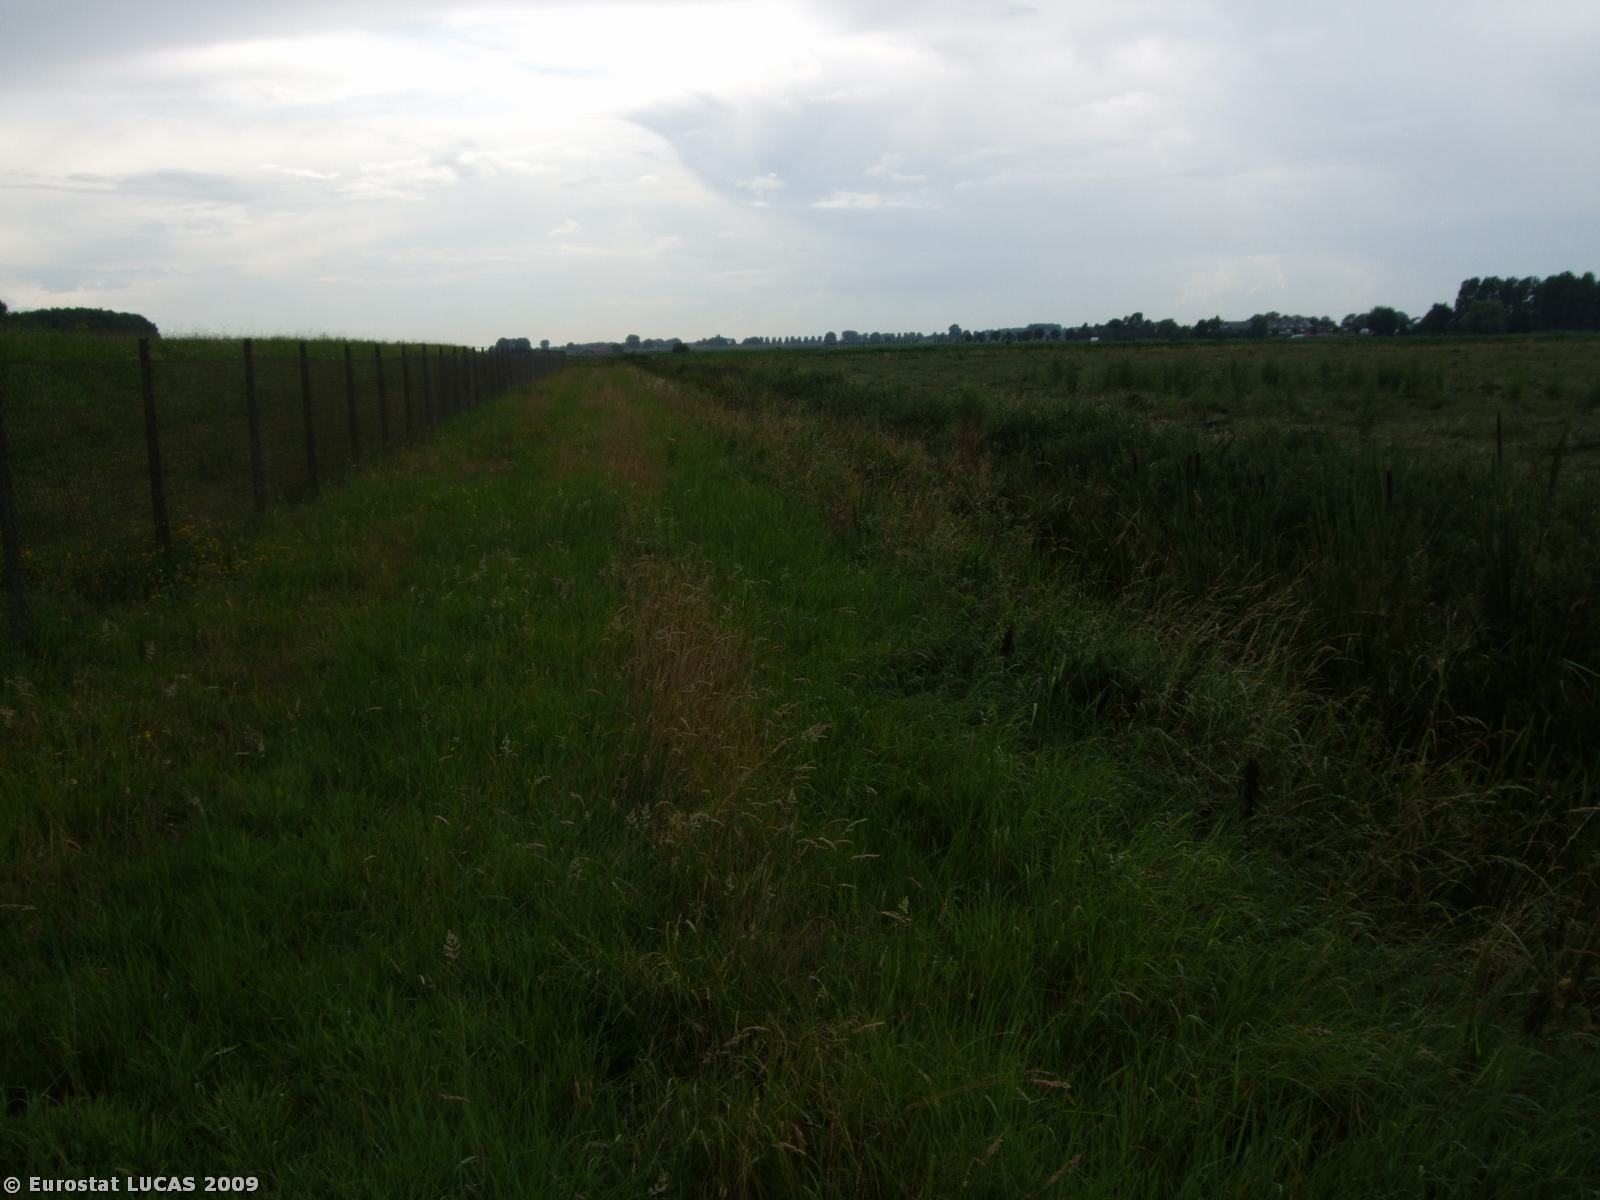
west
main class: Grassland
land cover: Grassland without tree/shrub cover
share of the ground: > 75 %
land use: Agriculture (excluding fallow land and kitchen gardens)
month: July
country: NL
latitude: 51.7844
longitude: 5.4028
